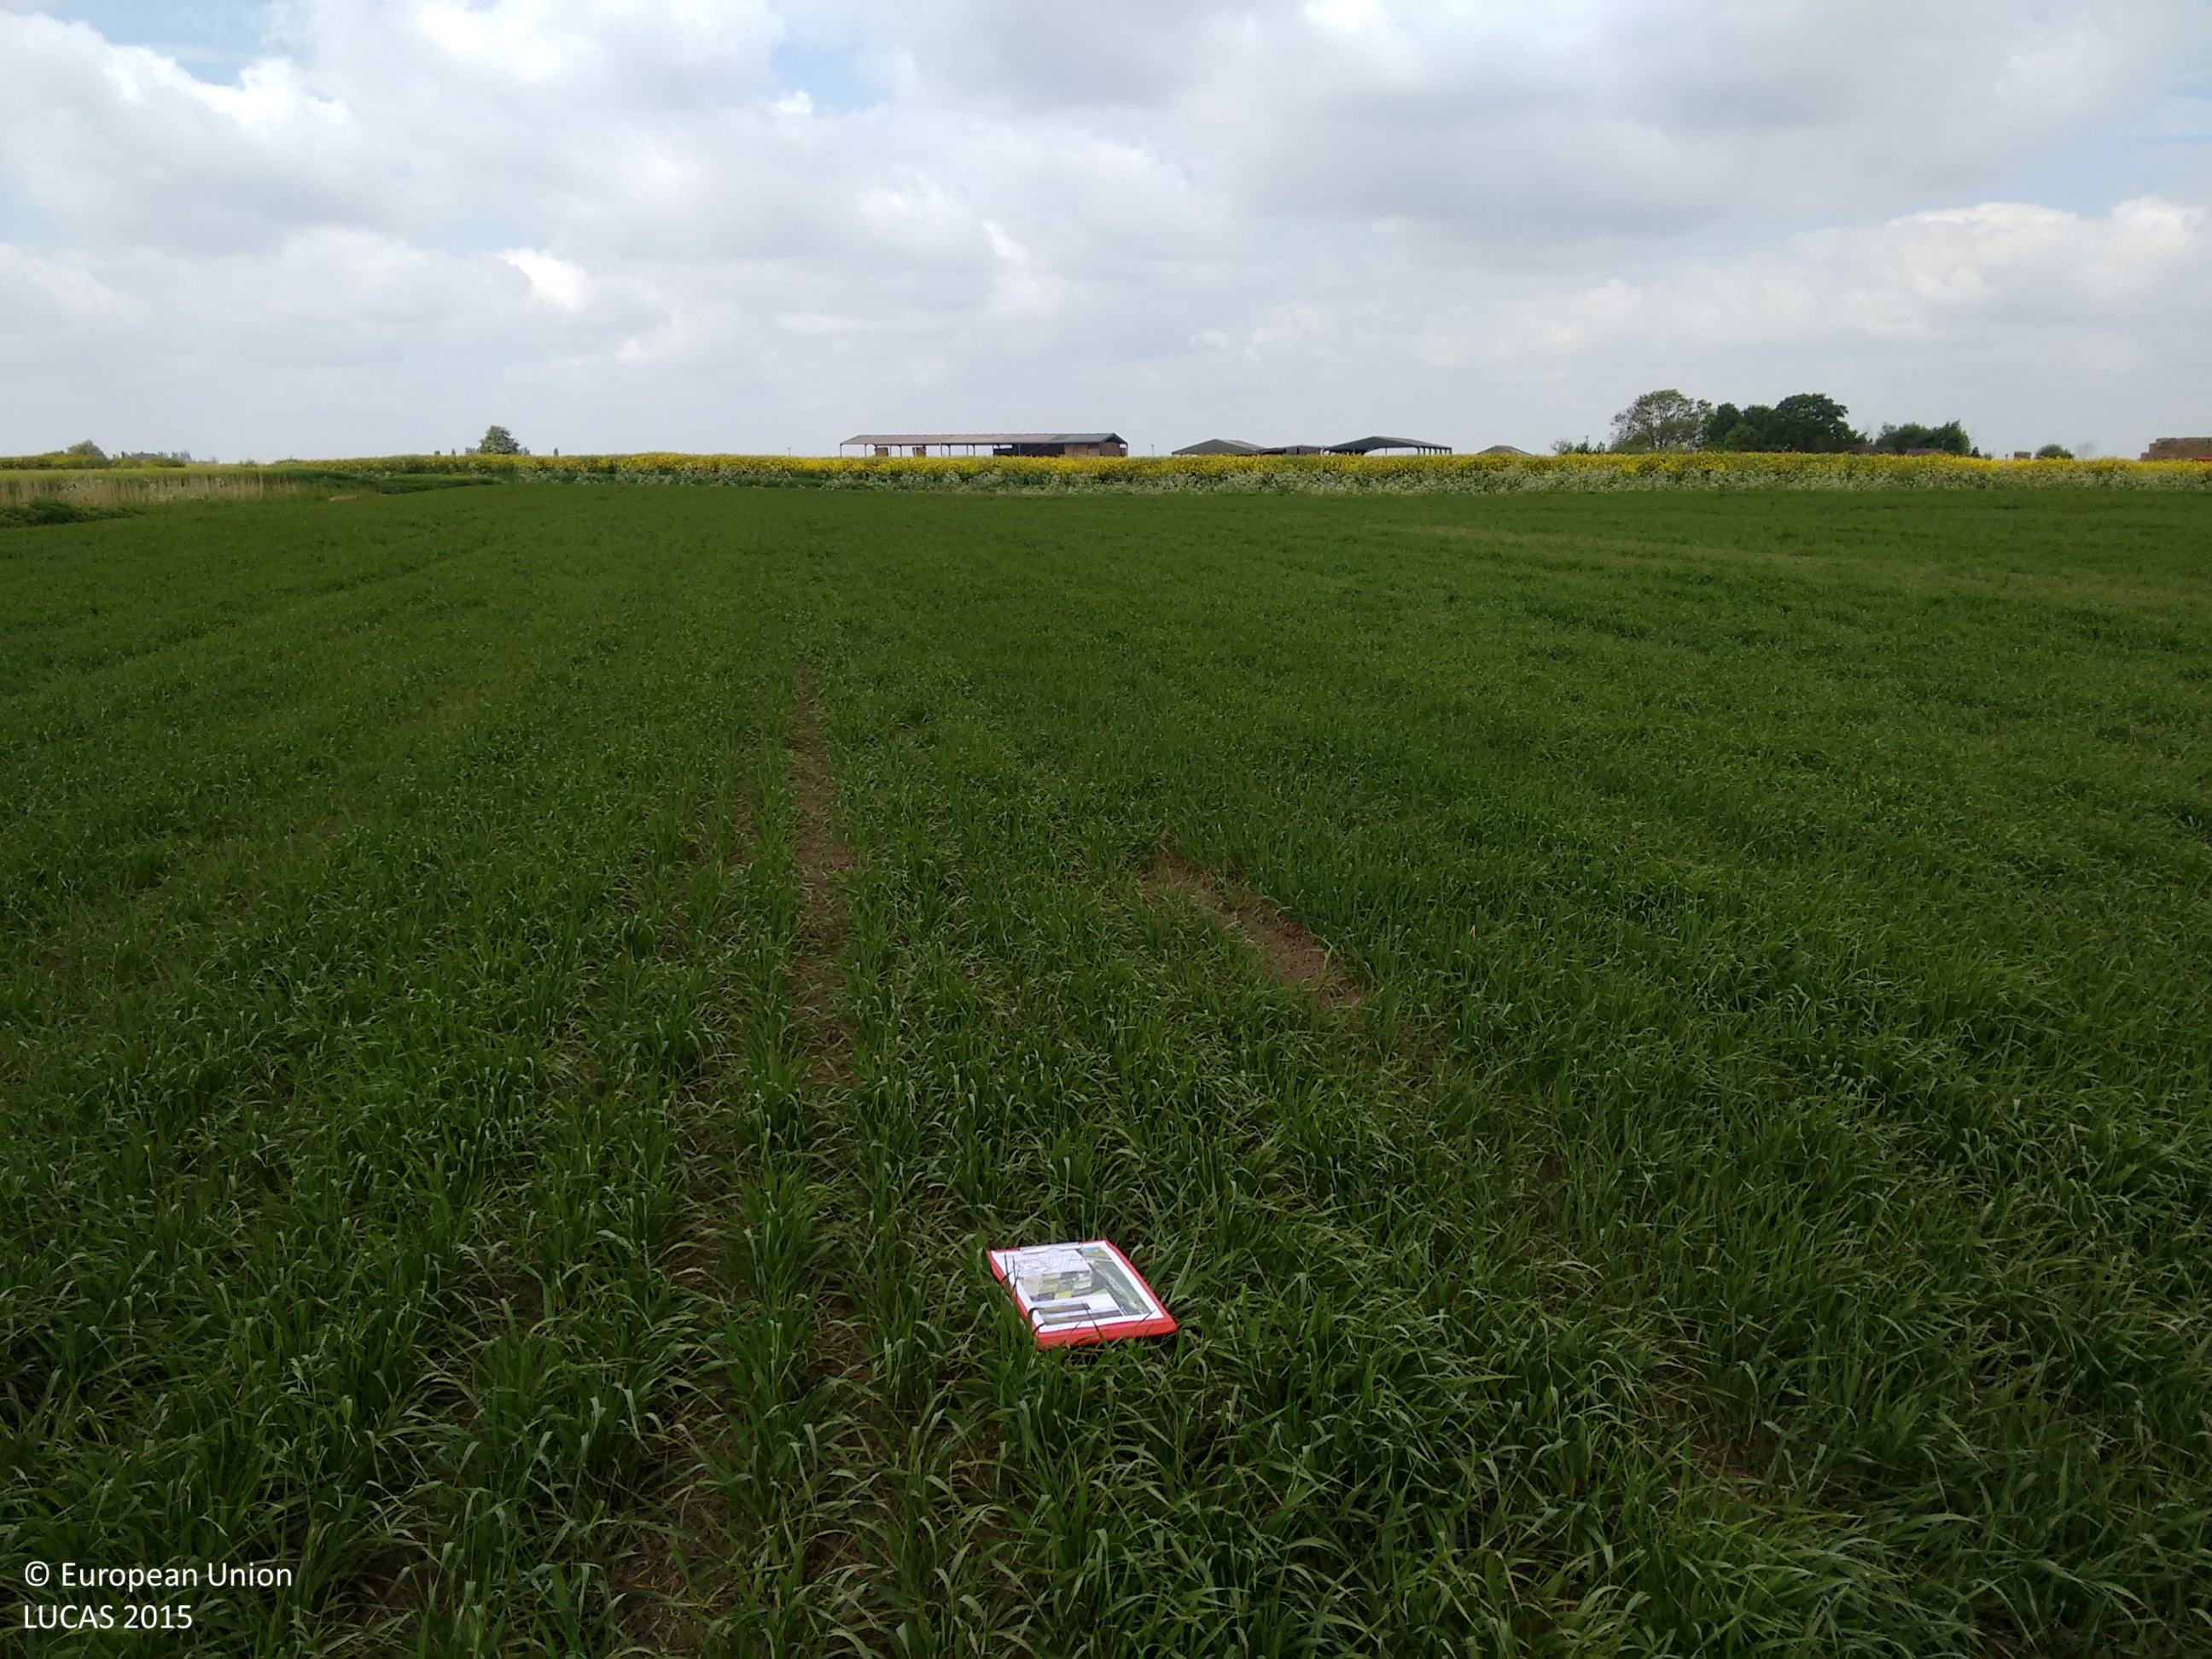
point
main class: Cropland
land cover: Barley
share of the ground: > 75 %
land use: Agriculture (excluding fallow land and kitchen gardens)
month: May
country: GB
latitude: 52.7132
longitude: -0.0244
